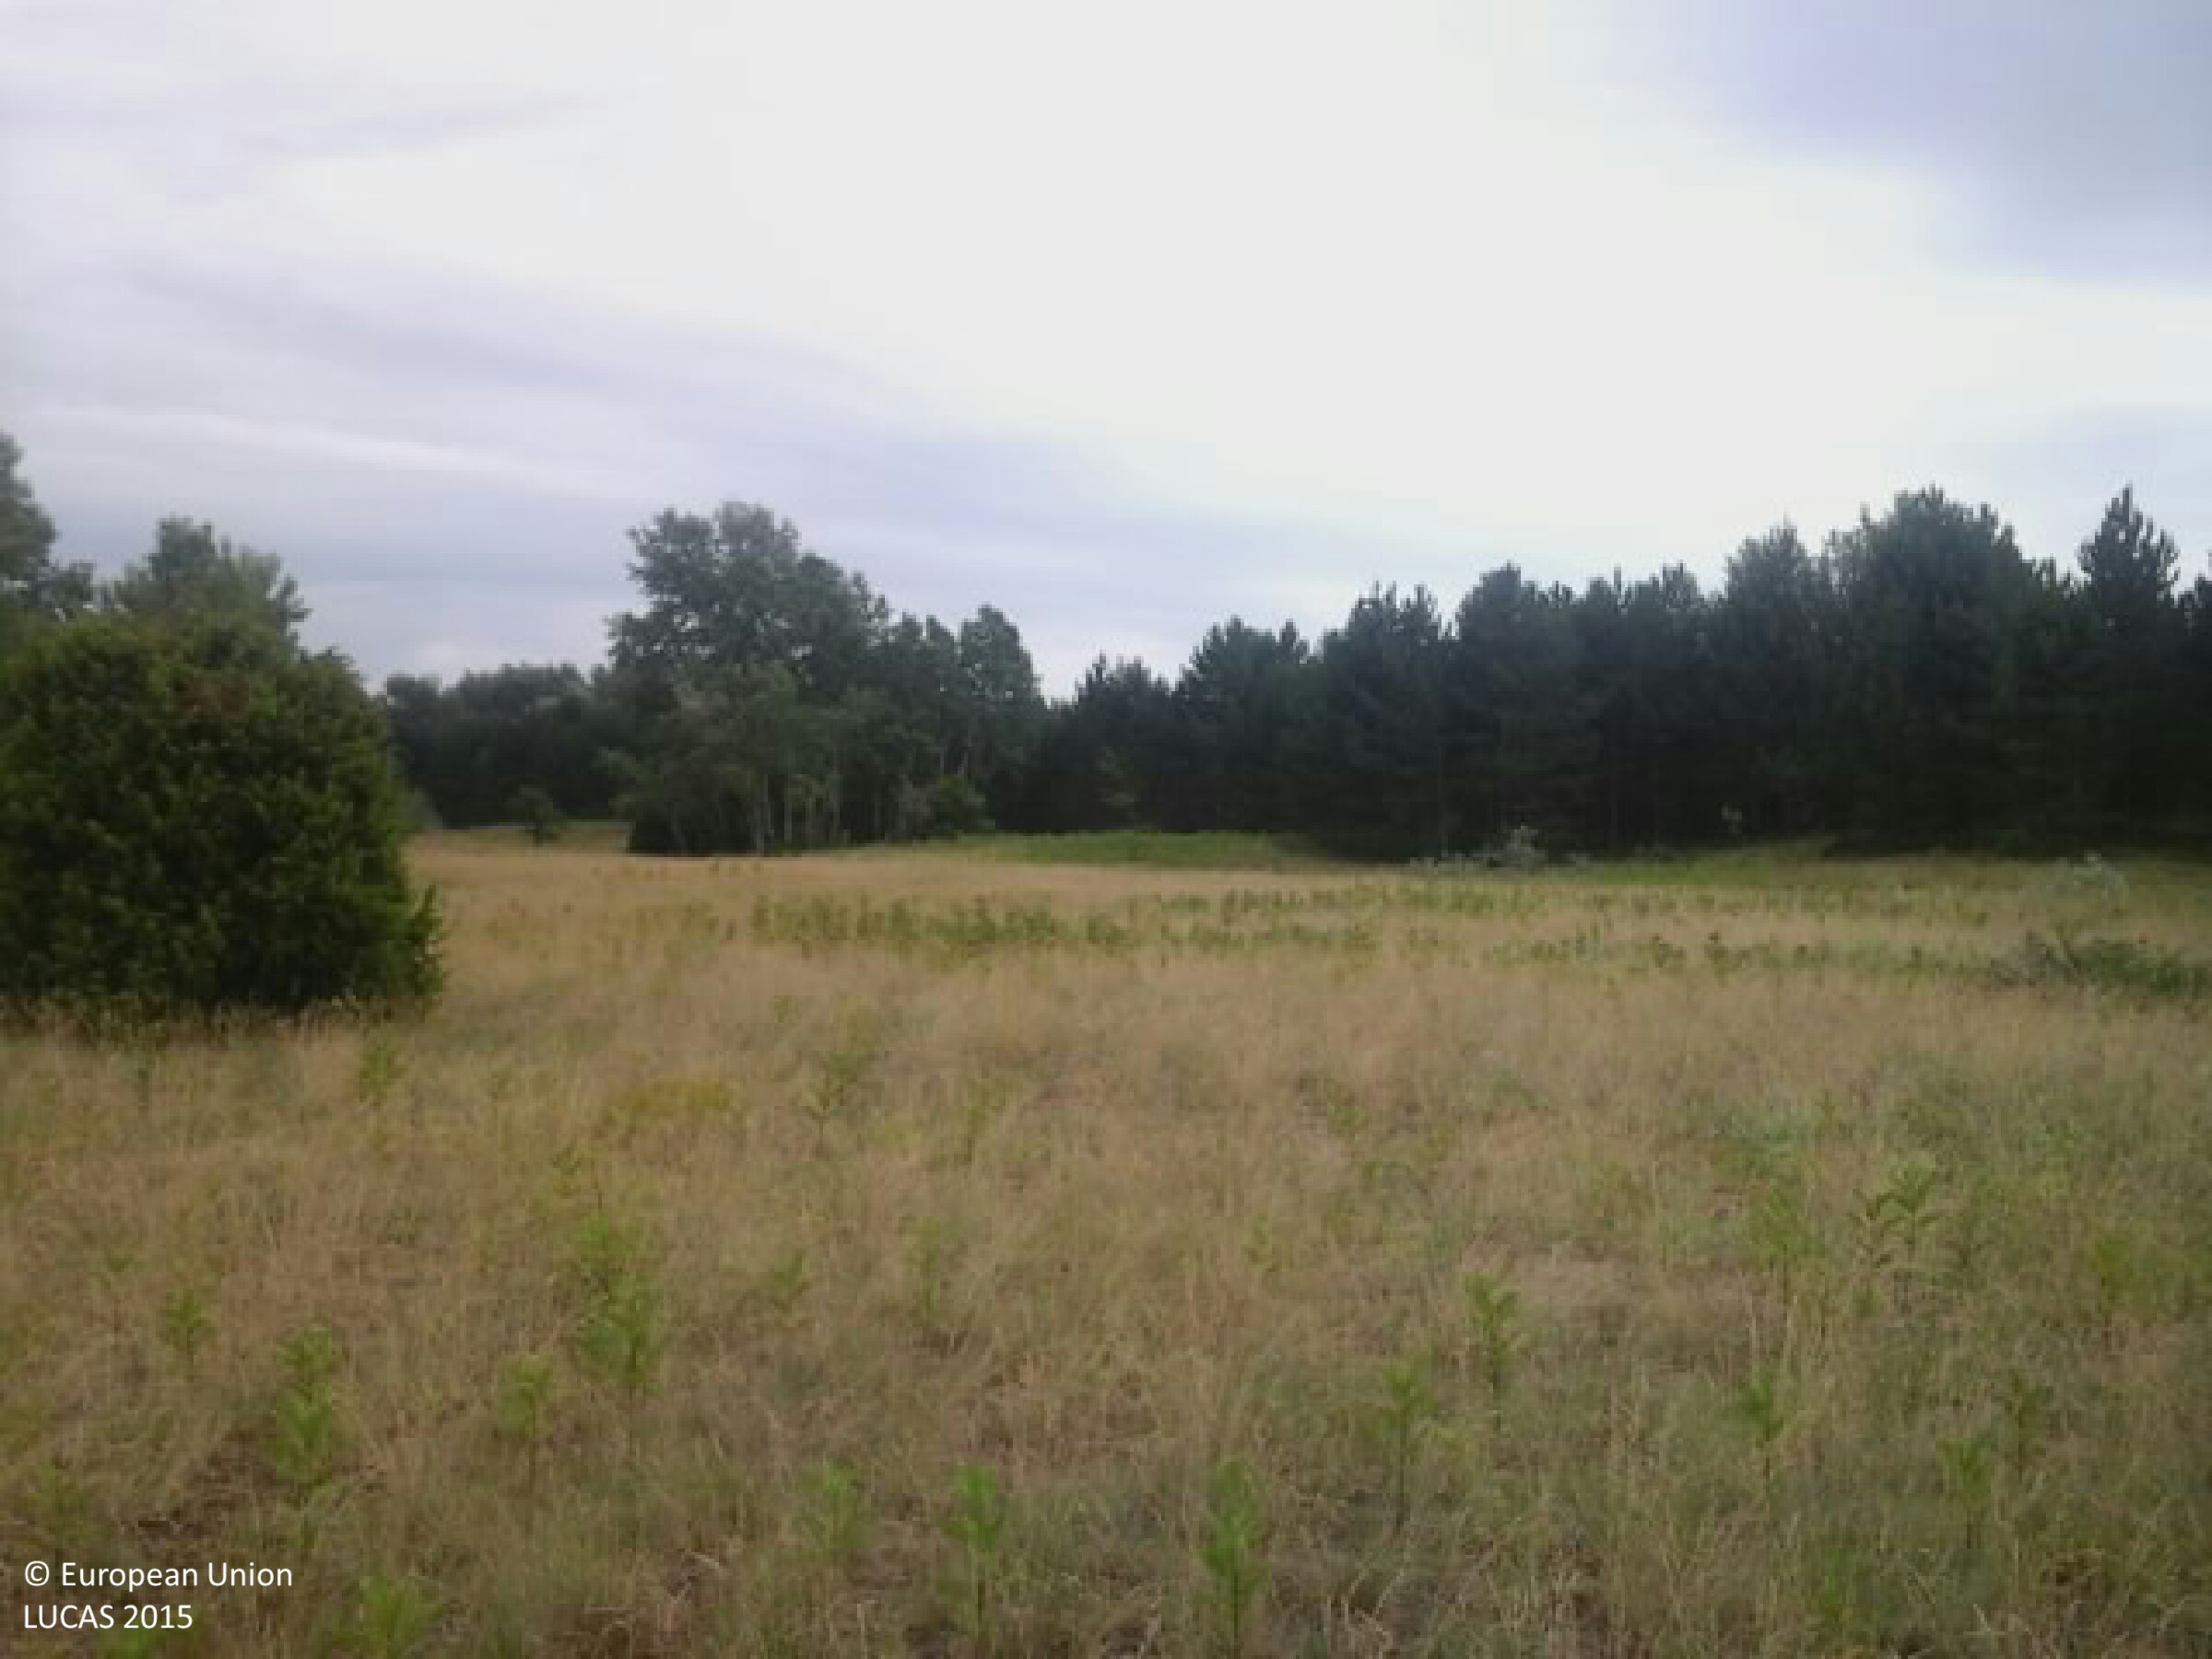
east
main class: Grassland
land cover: Grassland without tree/shrub cover
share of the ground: > 75 %
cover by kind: herbaceous plants 100 %
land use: Abandoned areas
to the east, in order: Grassland without tree/shrub cover; Broadleaved woodland
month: June
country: HU
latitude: 46.7667
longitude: 19.6441
